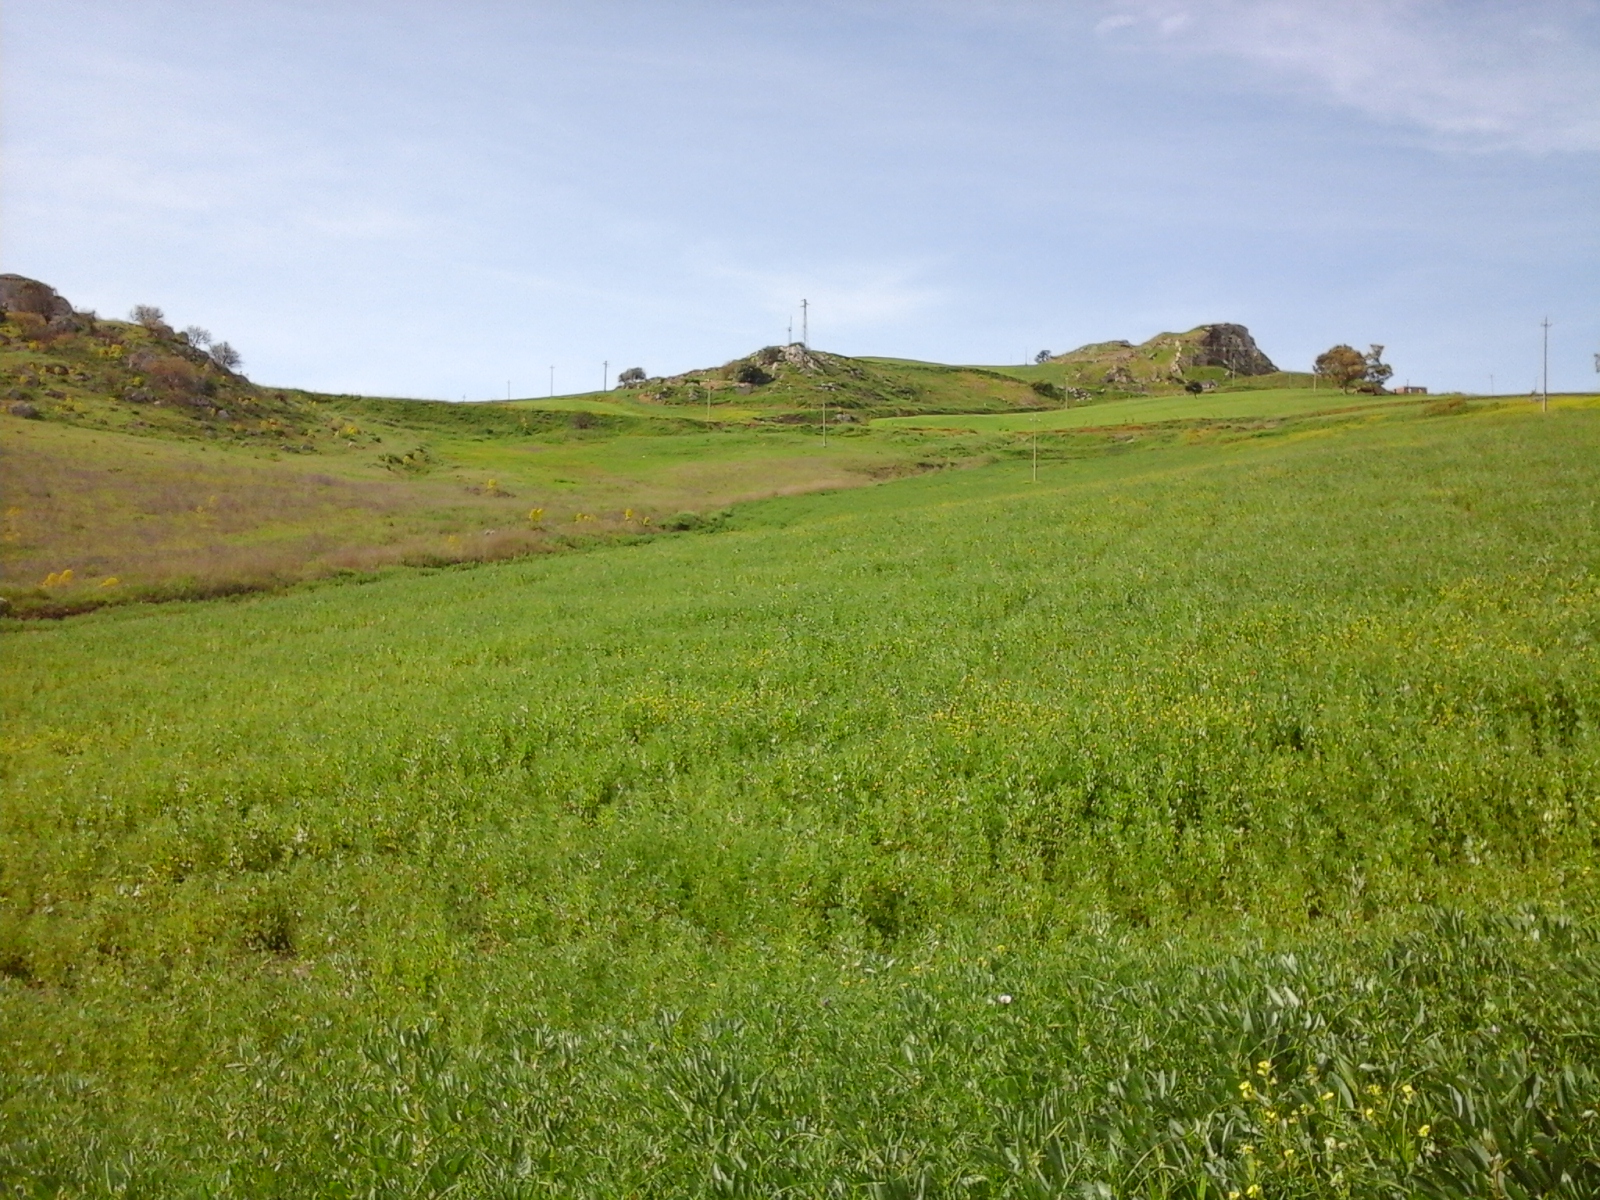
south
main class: Cropland
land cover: Other leguminous and mixtures for fodder
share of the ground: > 75 %
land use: Agriculture (excluding fallow land and kitchen gardens)
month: May
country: IT
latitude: 37.4403
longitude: 14.1170
